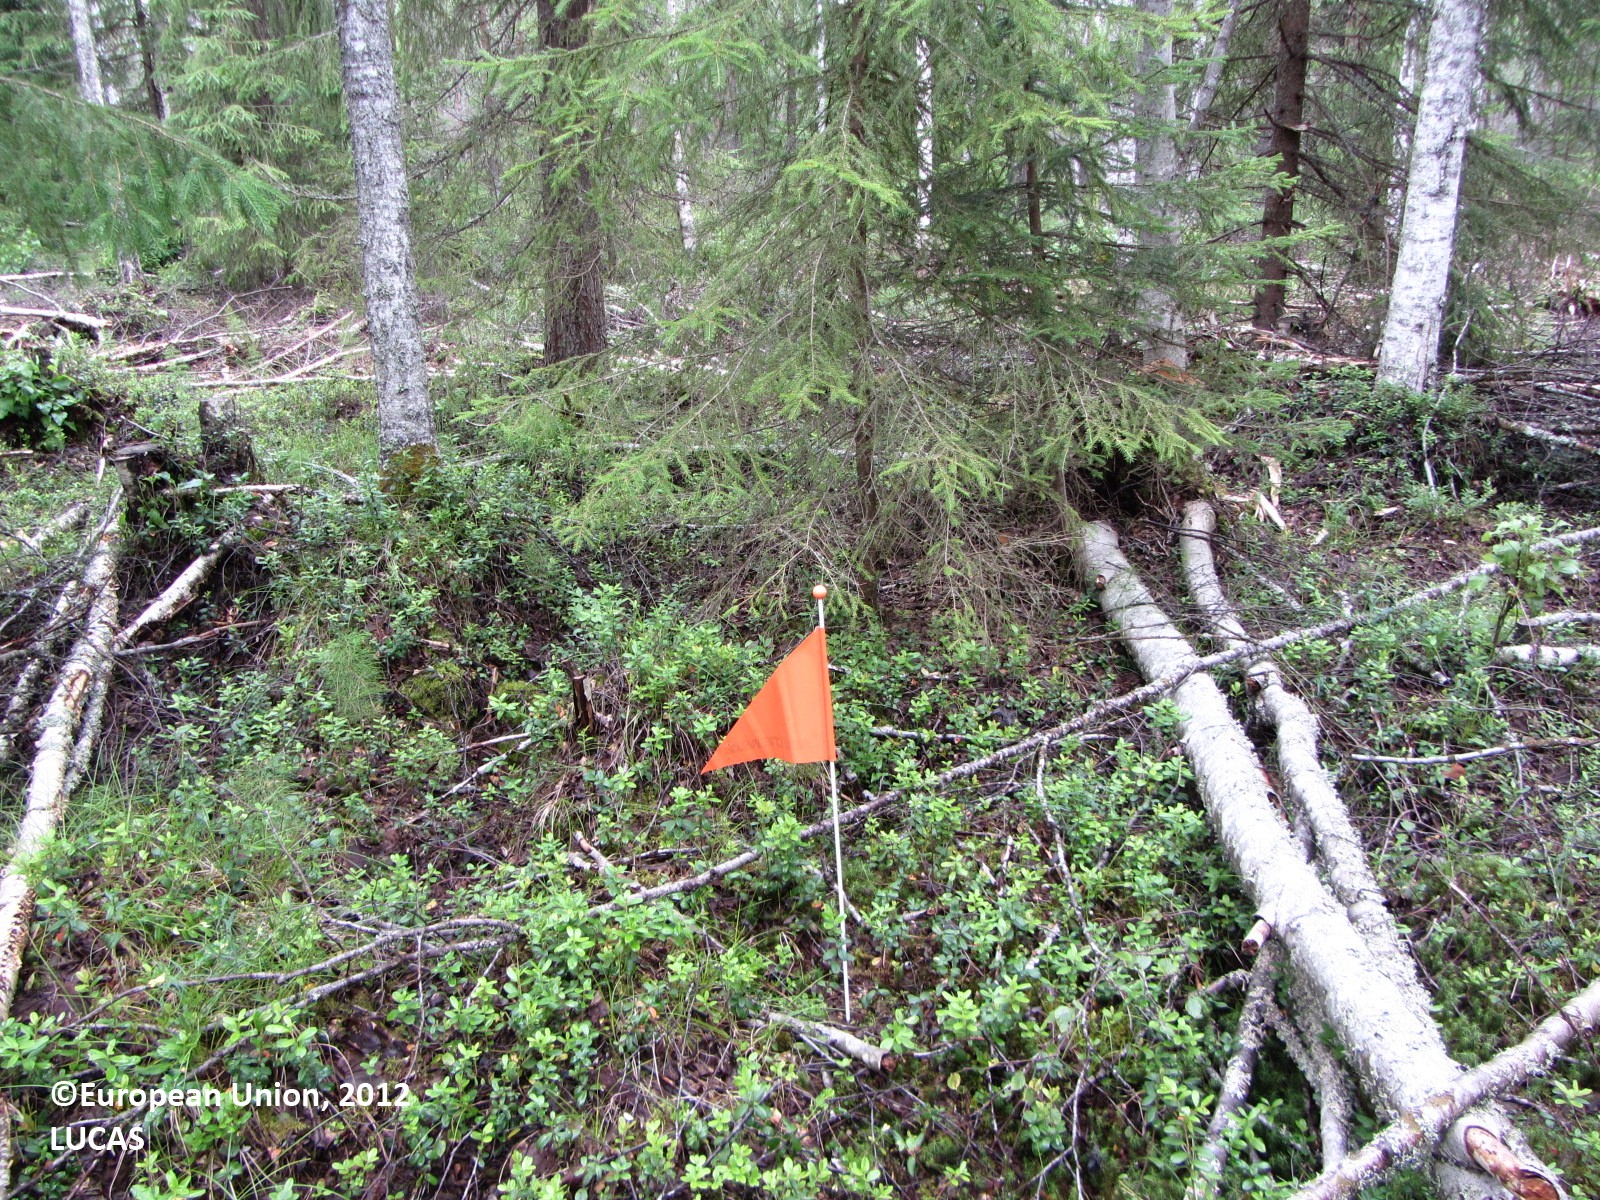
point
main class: Woodland
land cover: Other mixed woodland
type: boreal forest
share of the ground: 50 - 75 %
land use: Forestry
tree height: > 5 m
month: July
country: FI
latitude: 63.8905
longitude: 24.7236
